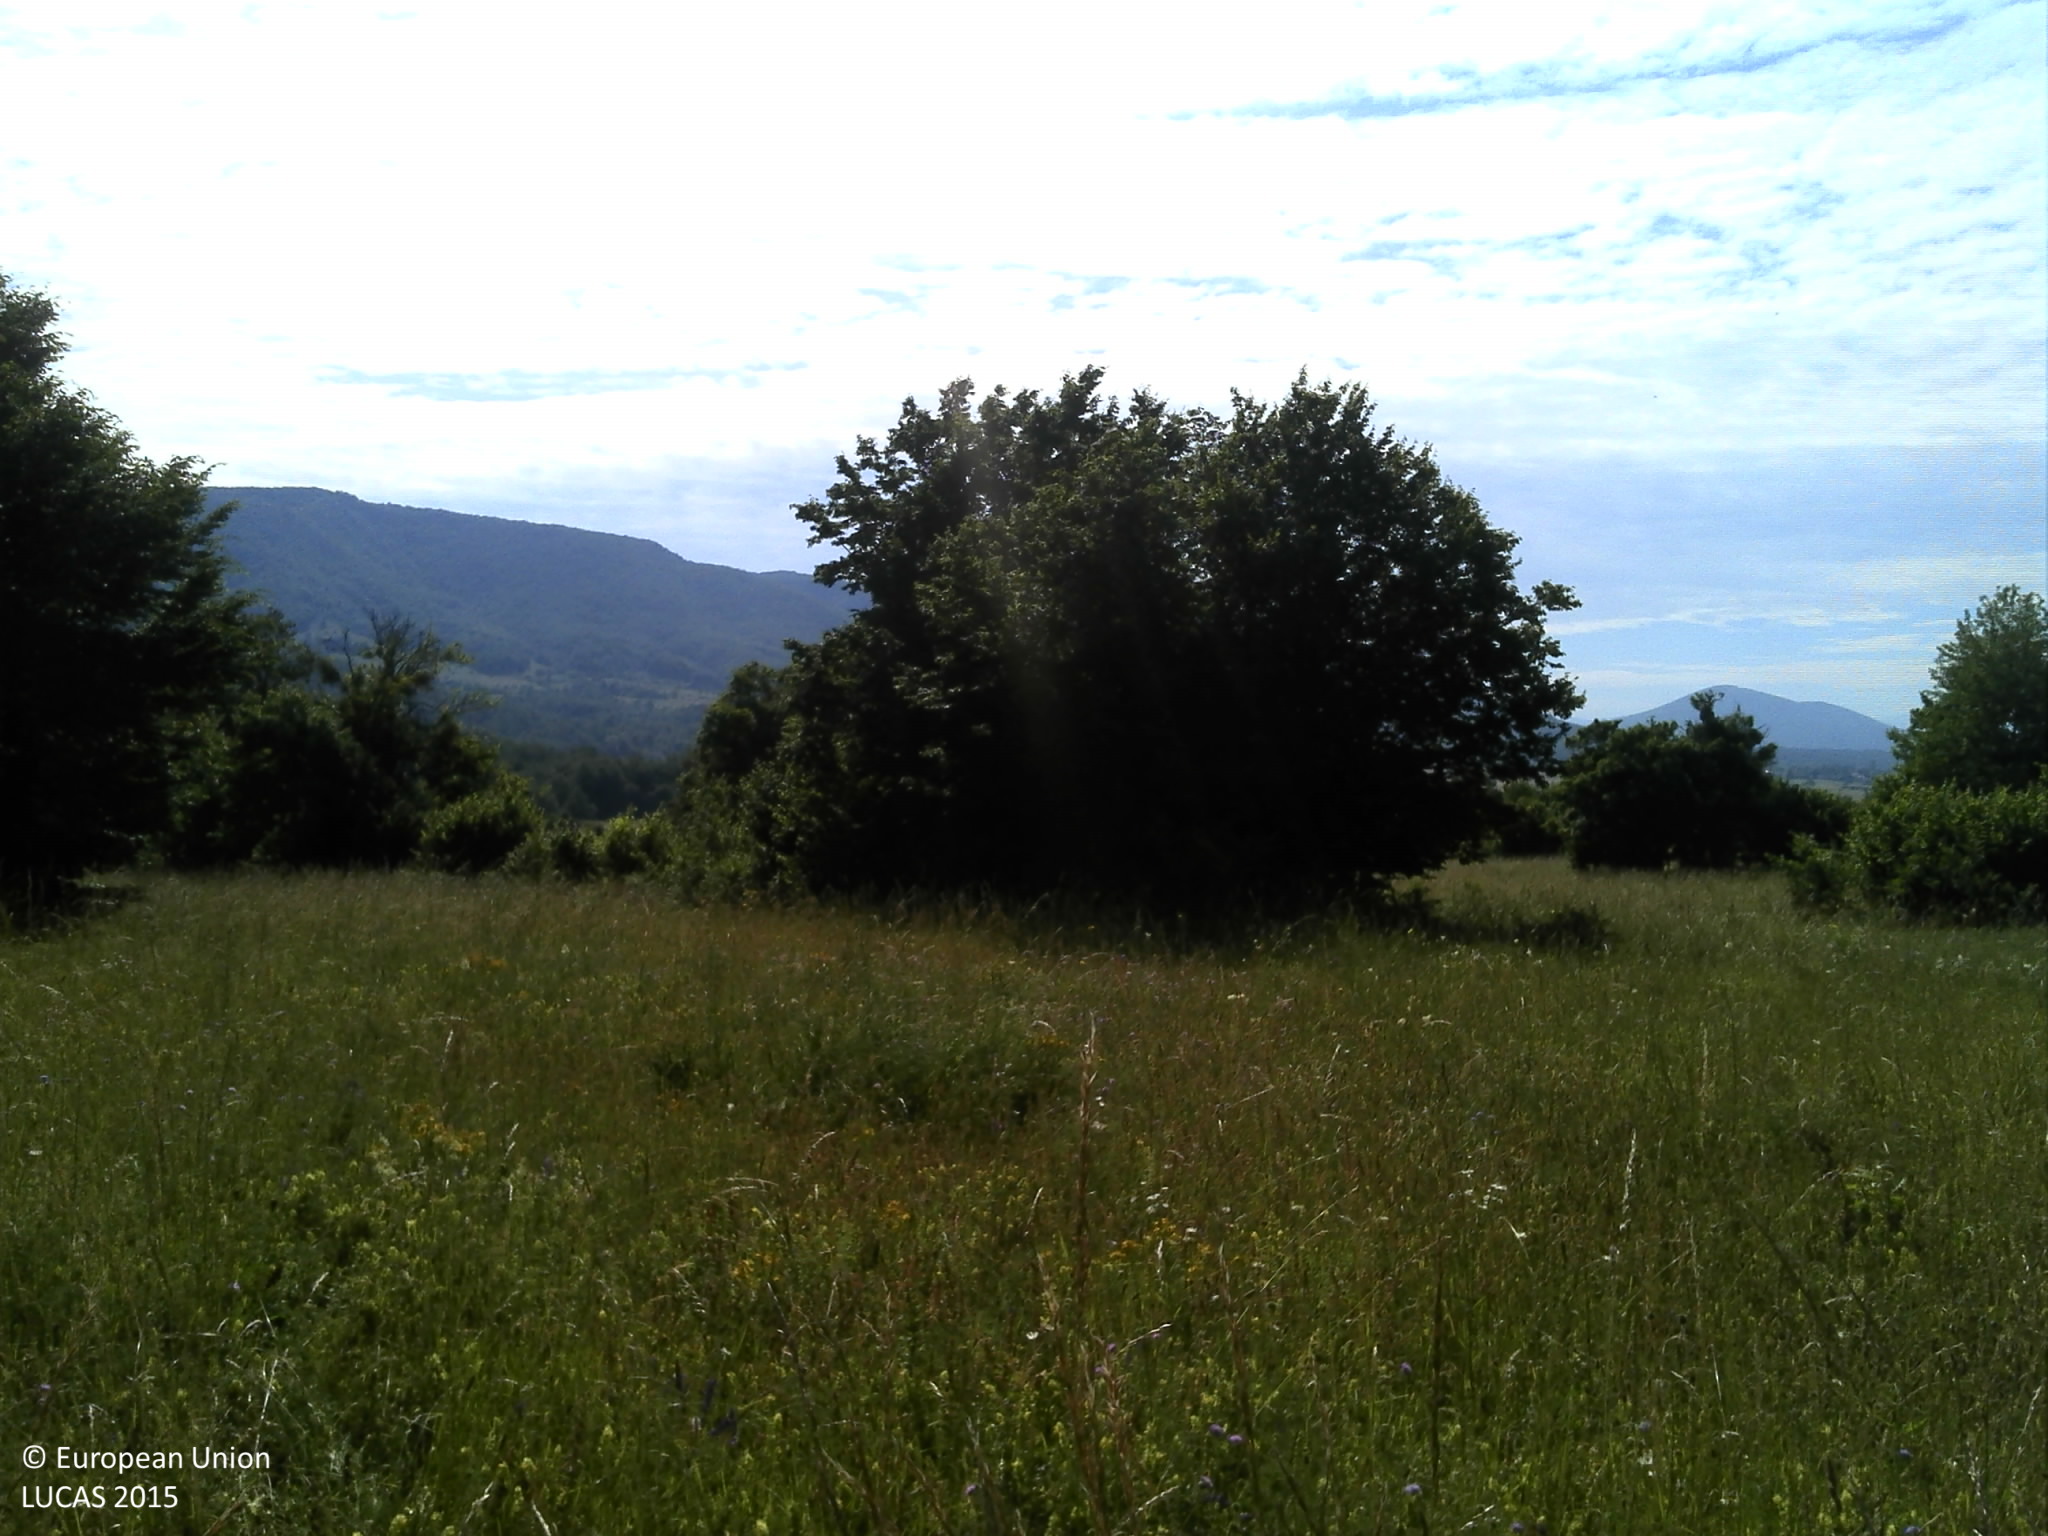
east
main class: Grassland
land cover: Grassland without tree/shrub cover
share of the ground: > 75 %
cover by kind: herbaceous plants 100 %
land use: Semi-natural and natural areas not in use
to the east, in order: Grassland without tree/shrub cover; Broadleaved woodland; Grassland without tree/shrub cover; Grassland with sparse tree/shrub cover; Shrubland with sparse tree cover; Grassland without tree/shrub cover; Shrubland with sparse tree cover; Tracks; Shrubland without tree cover; Grassland without tree/shrub cover
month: June
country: HR
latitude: 44.5789
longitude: 15.9258
